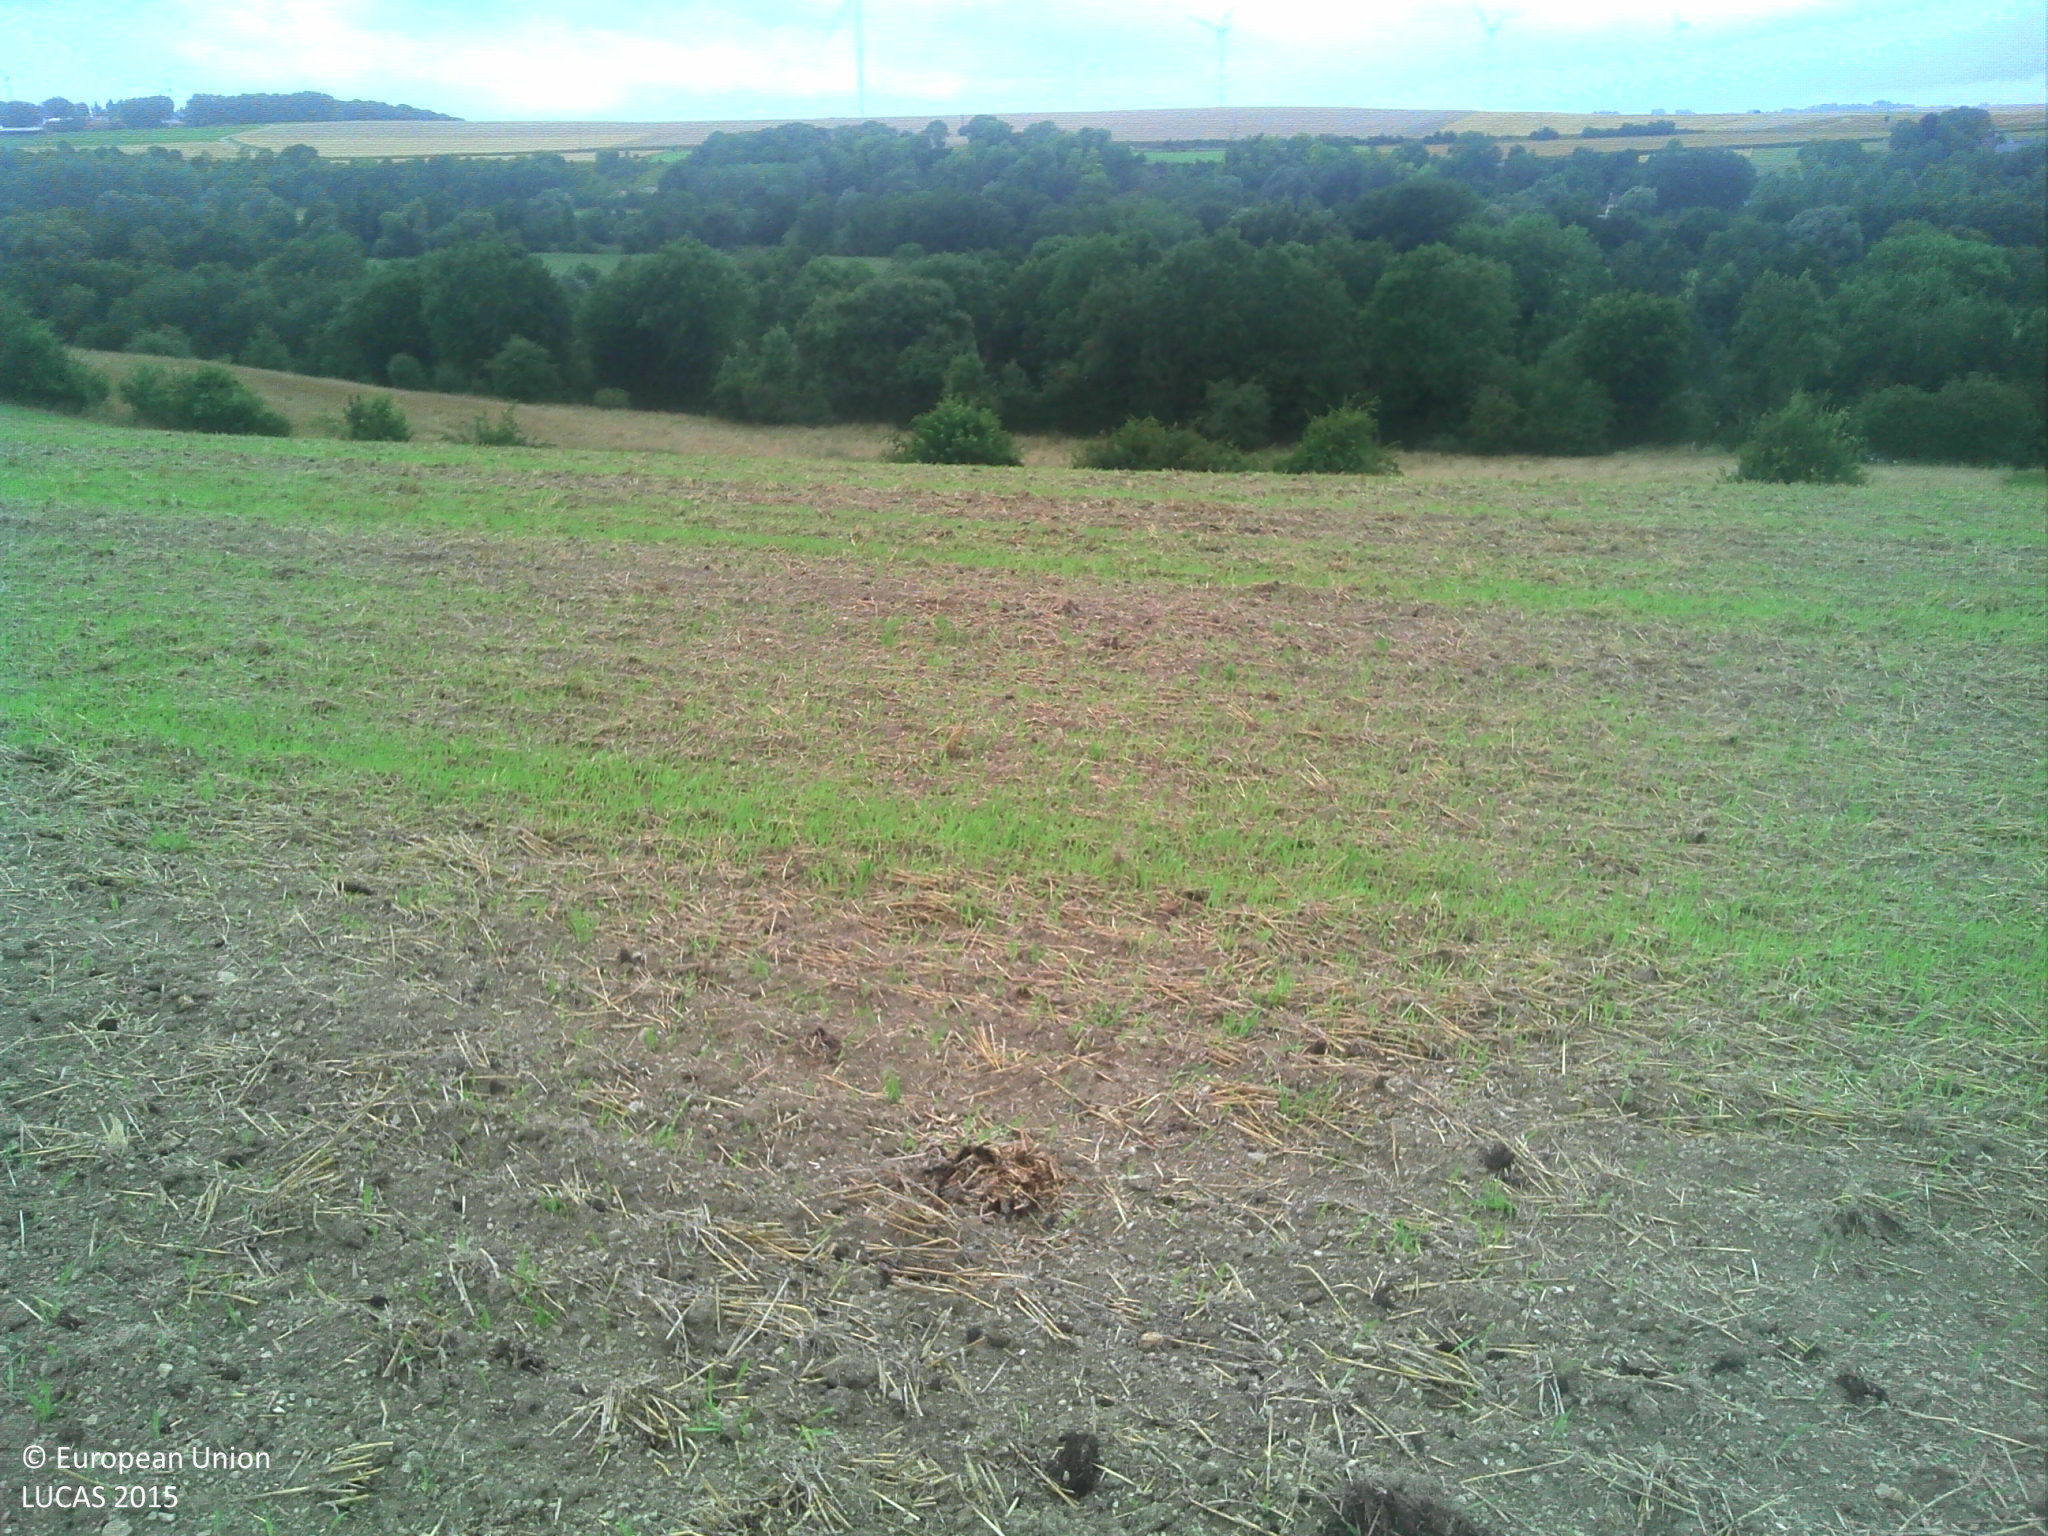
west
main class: Cropland
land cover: Barley
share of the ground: 25 - 50 %
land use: Agriculture (excluding fallow land and kitchen gardens)
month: July
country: FR
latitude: 49.9127
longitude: 3.5730
